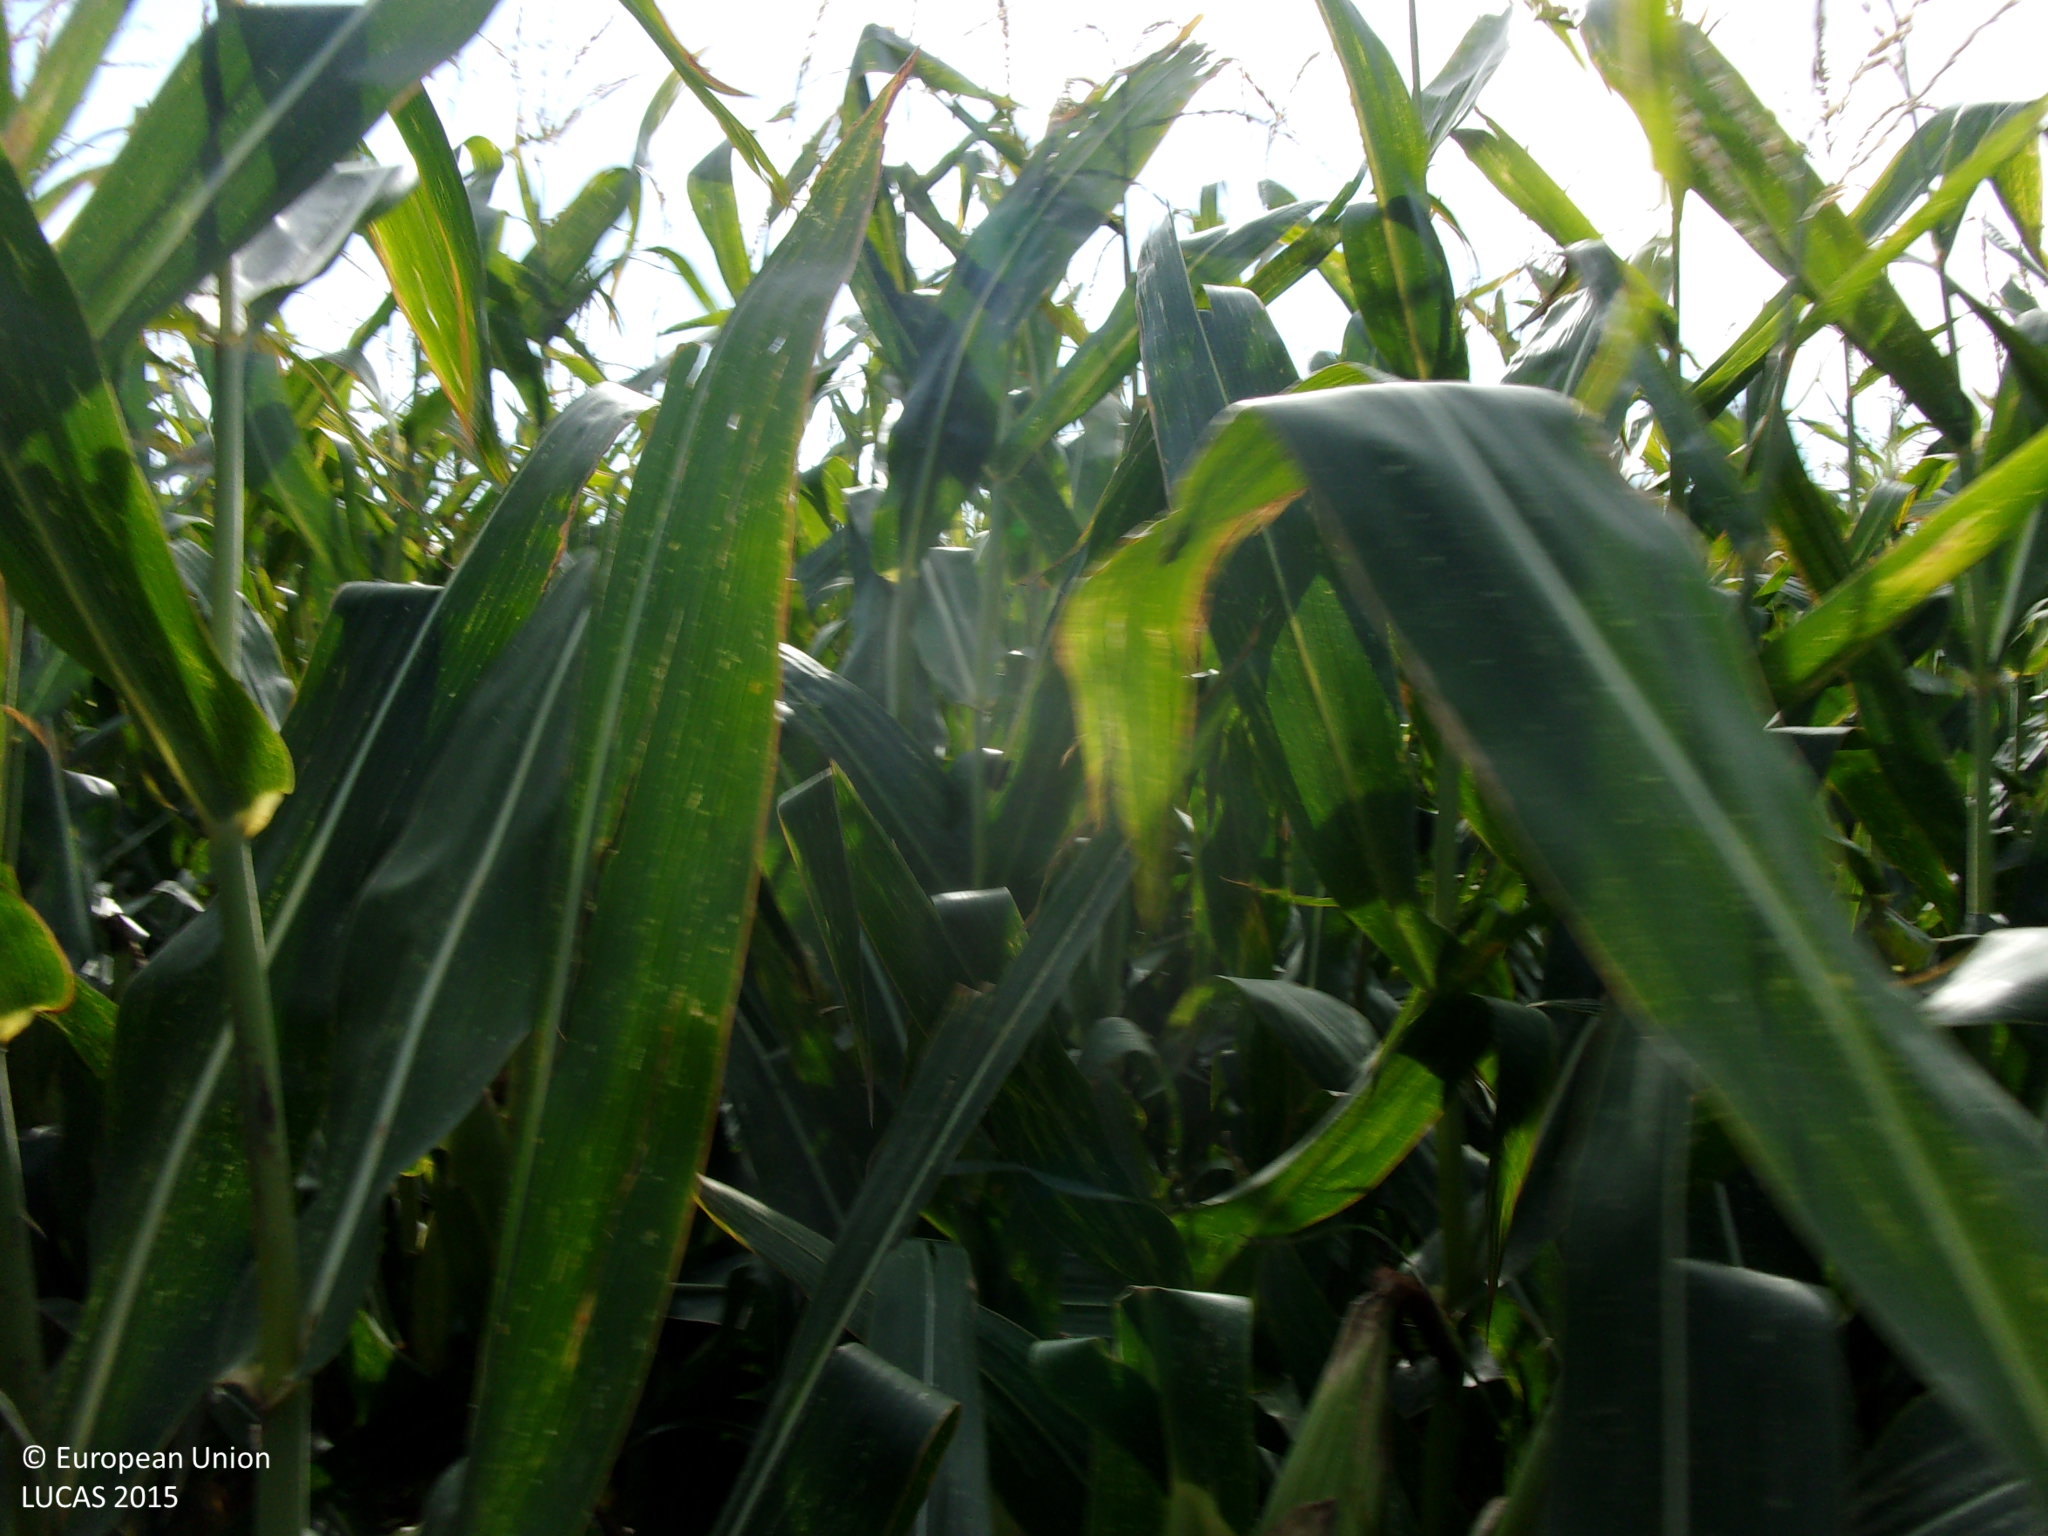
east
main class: Cropland
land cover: Maize
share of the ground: > 75 %
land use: Agriculture (excluding fallow land and kitchen gardens)
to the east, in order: Maize; Lucerne
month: August
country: ES
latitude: 42.0388
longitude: -1.1289
